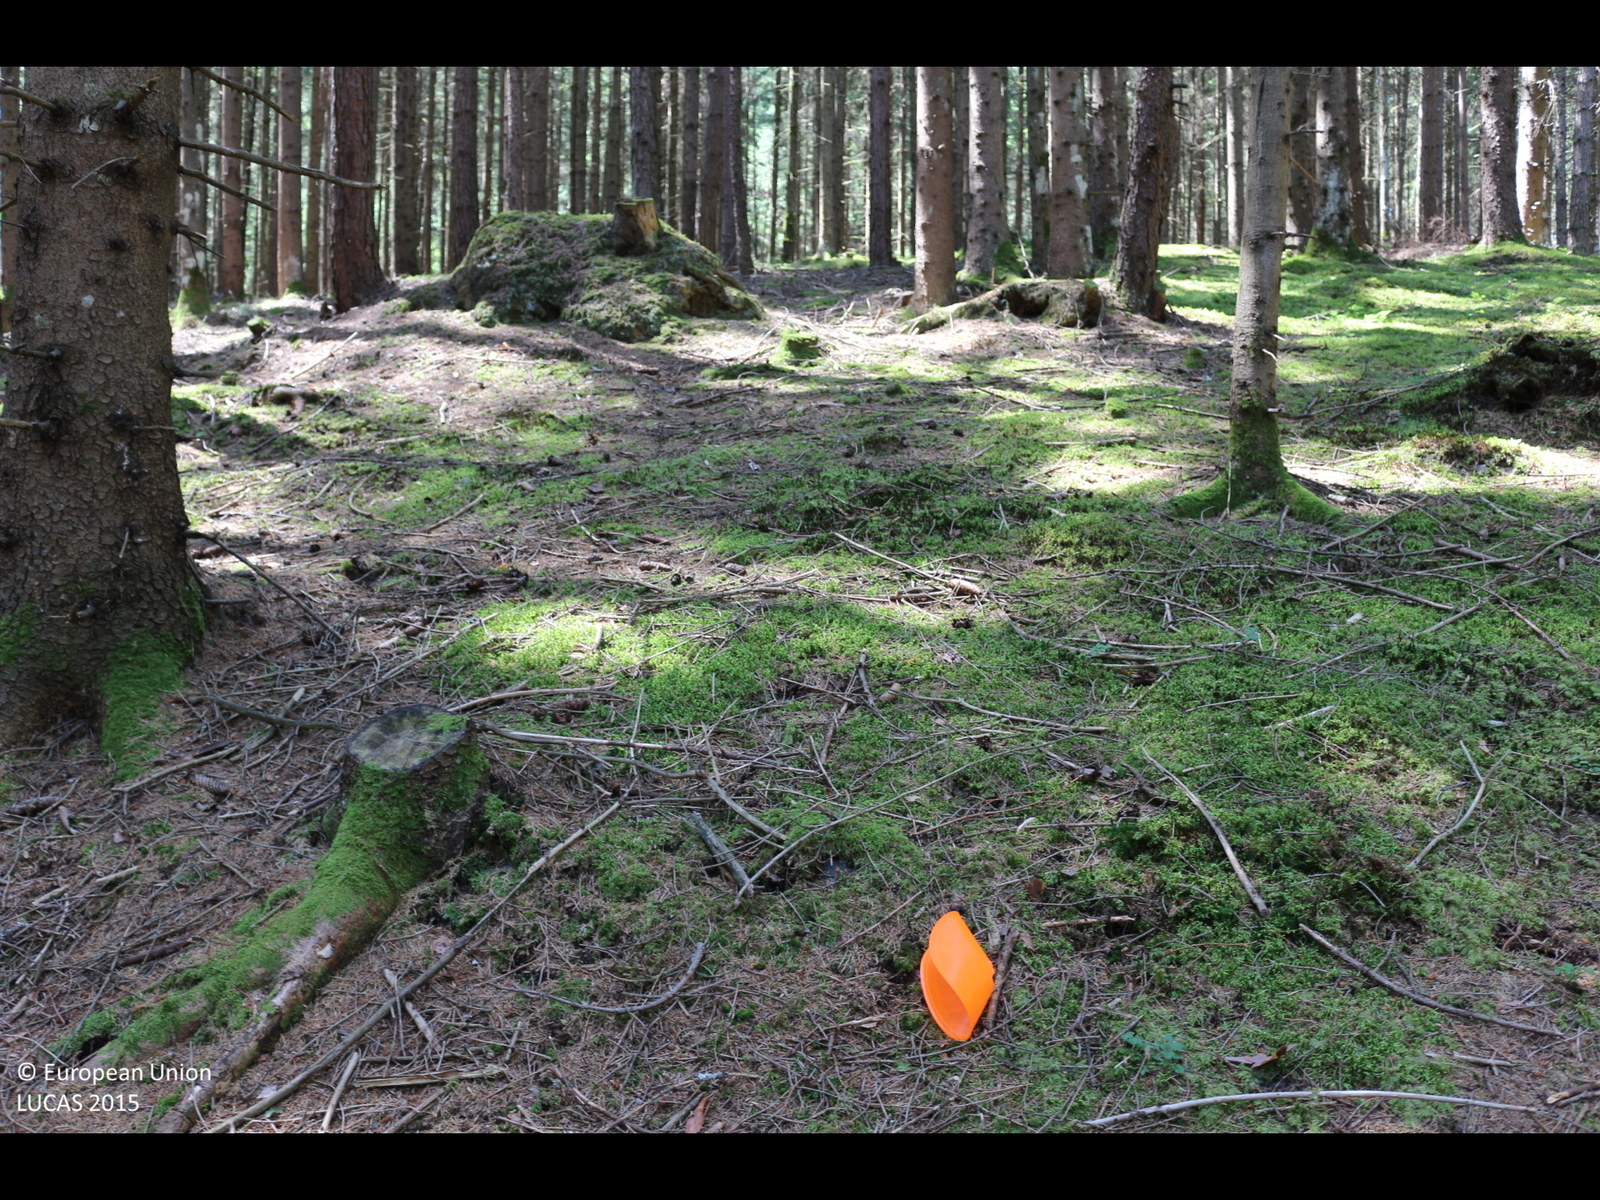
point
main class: Woodland
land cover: Spruce dominated coniferous woodland
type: alpine coniferous forest
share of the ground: > 75 %
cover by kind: coniferous forest trees 100 %
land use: Forestry
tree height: > 5 m
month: July
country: AT
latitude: 46.7235
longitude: 13.5954
